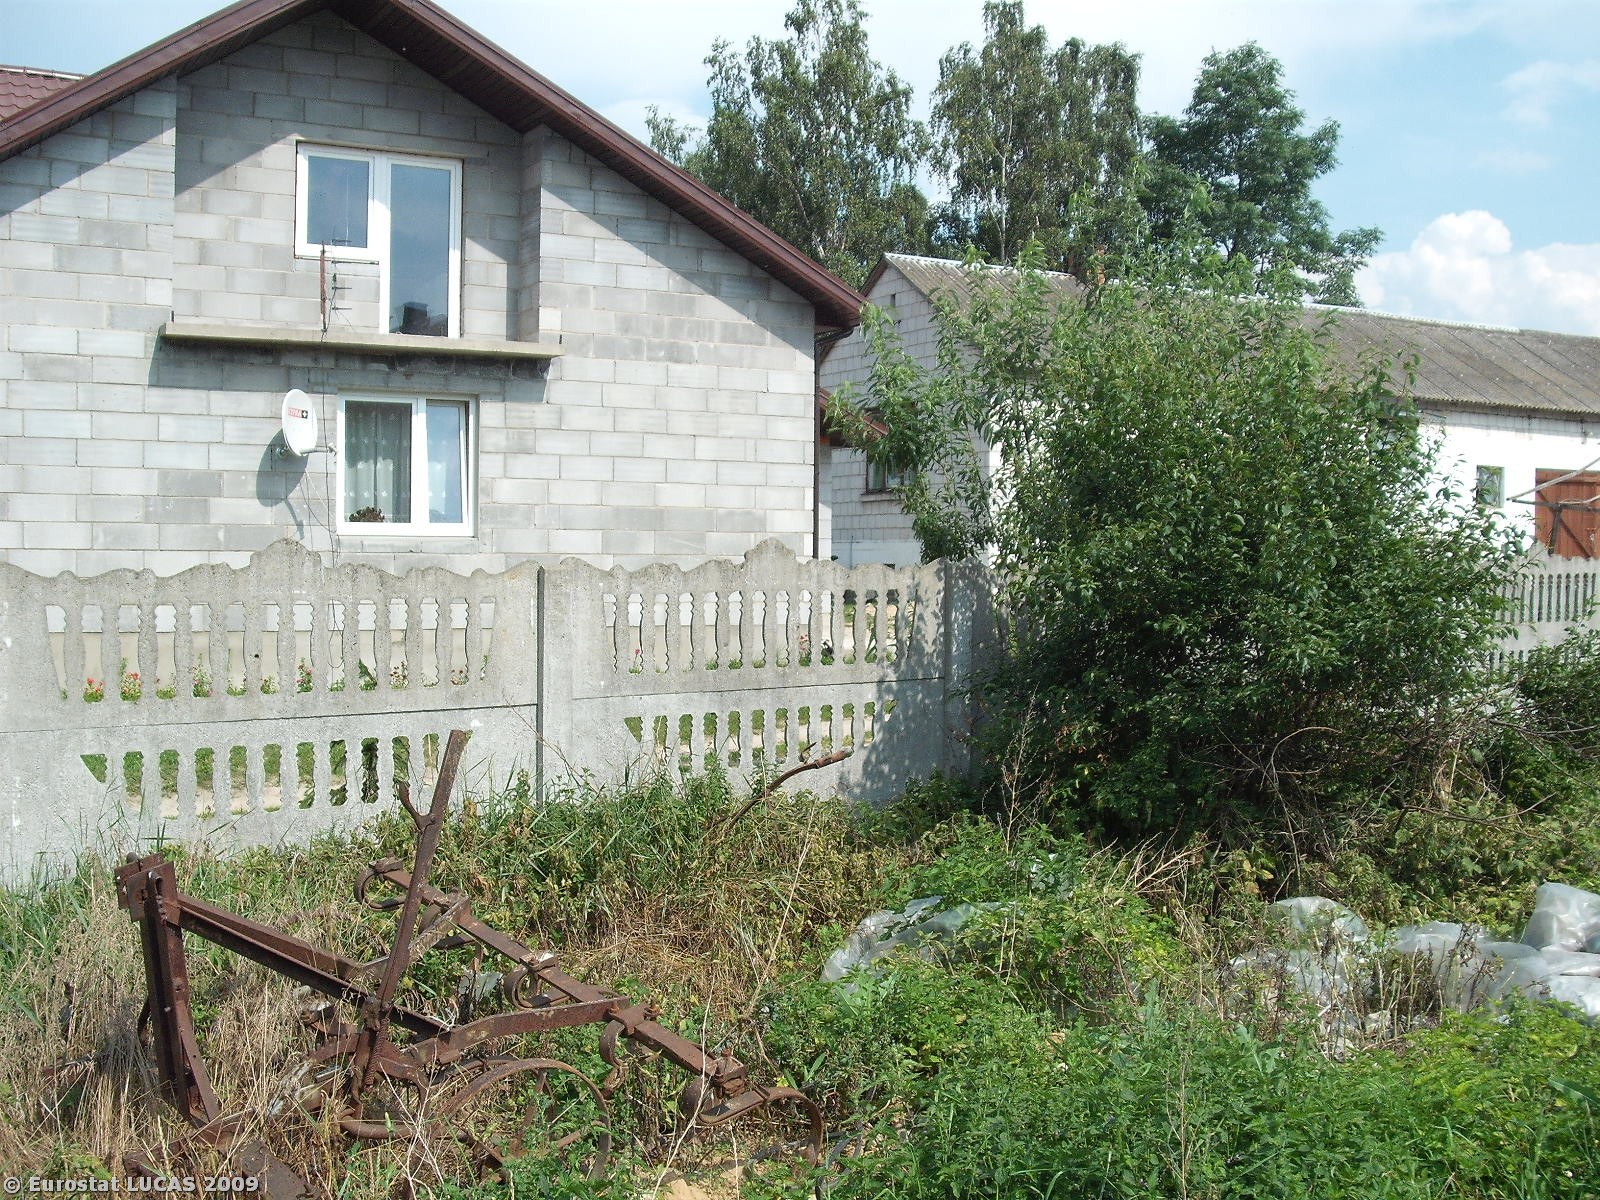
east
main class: Grassland
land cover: Spontaneously vegetated surfaces
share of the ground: > 75 %
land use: Unused
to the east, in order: Spontaneously vegetated surfaces; Artificial constructions in urban areas
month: July
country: PL
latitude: 51.5506
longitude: 20.6690
